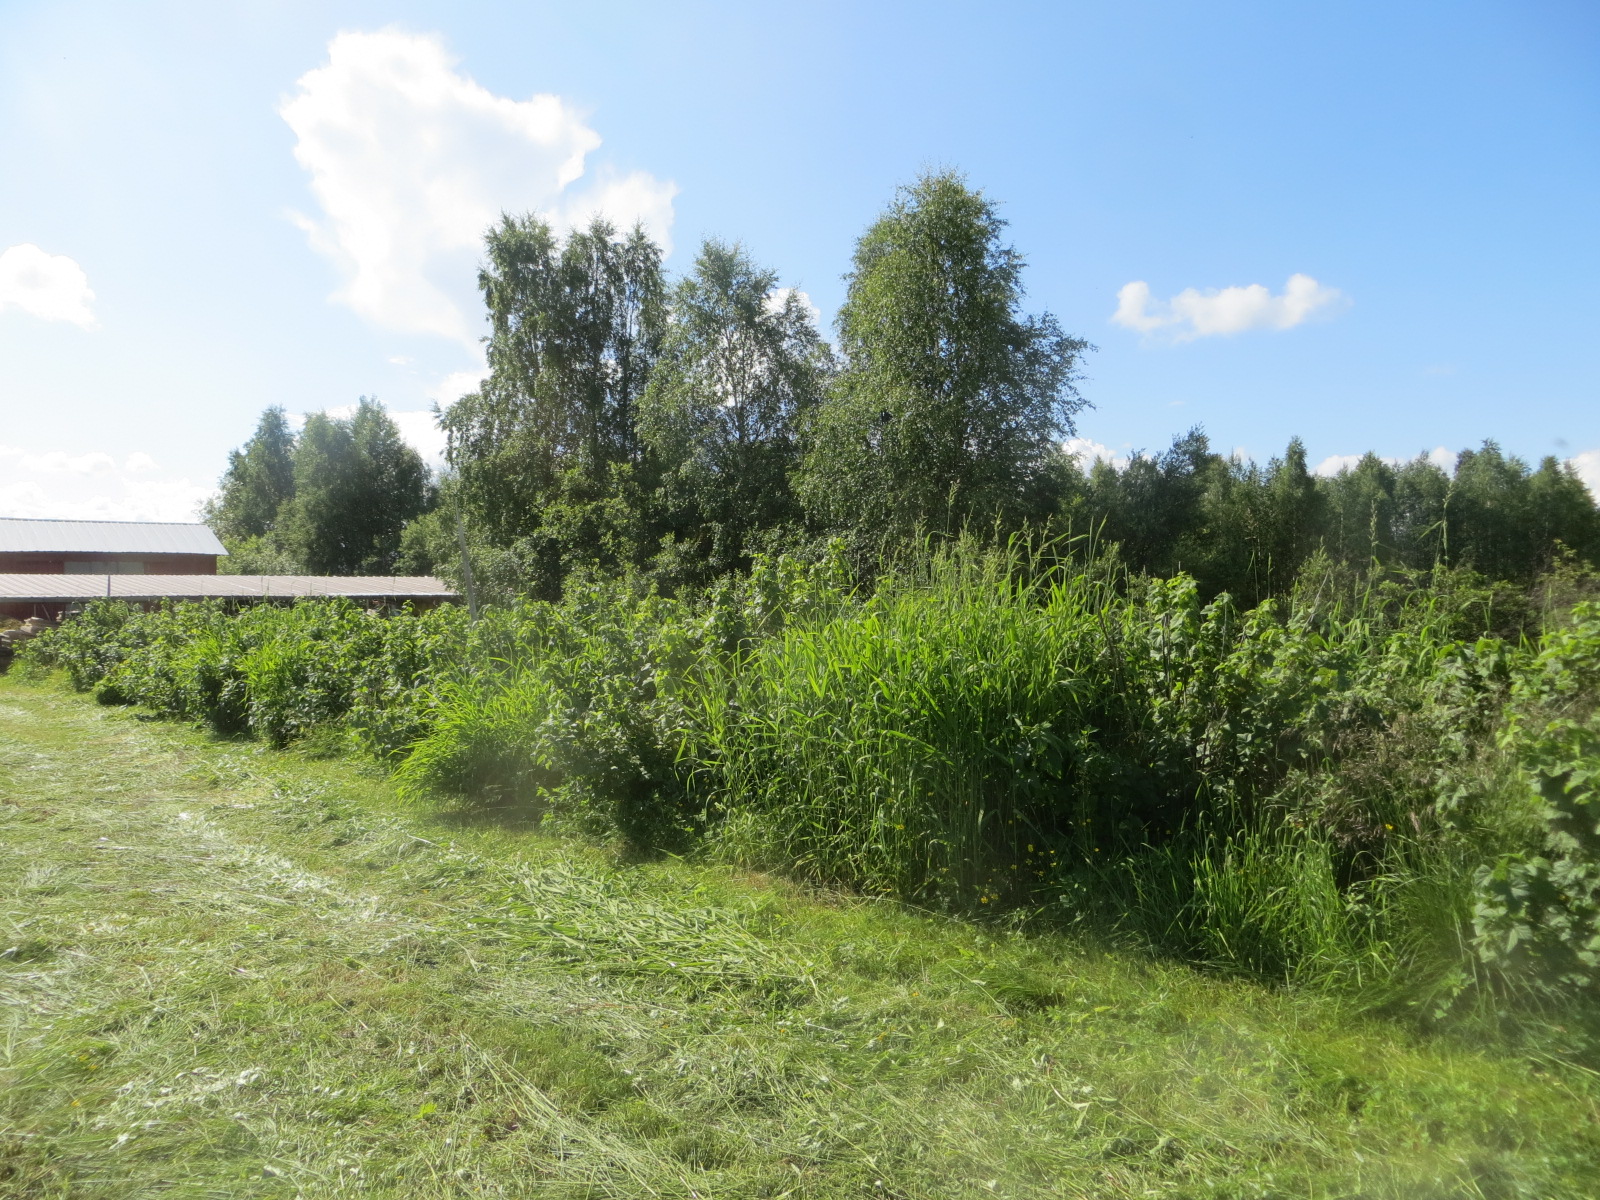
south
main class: Grassland
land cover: Grassland without tree/shrub cover
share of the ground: > 75 %
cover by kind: herbaceous plants 100 %
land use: Agriculture (excluding fallow land and kitchen gardens)
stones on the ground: < 10 %
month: July
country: FI
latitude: 66.4693
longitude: 25.6223
